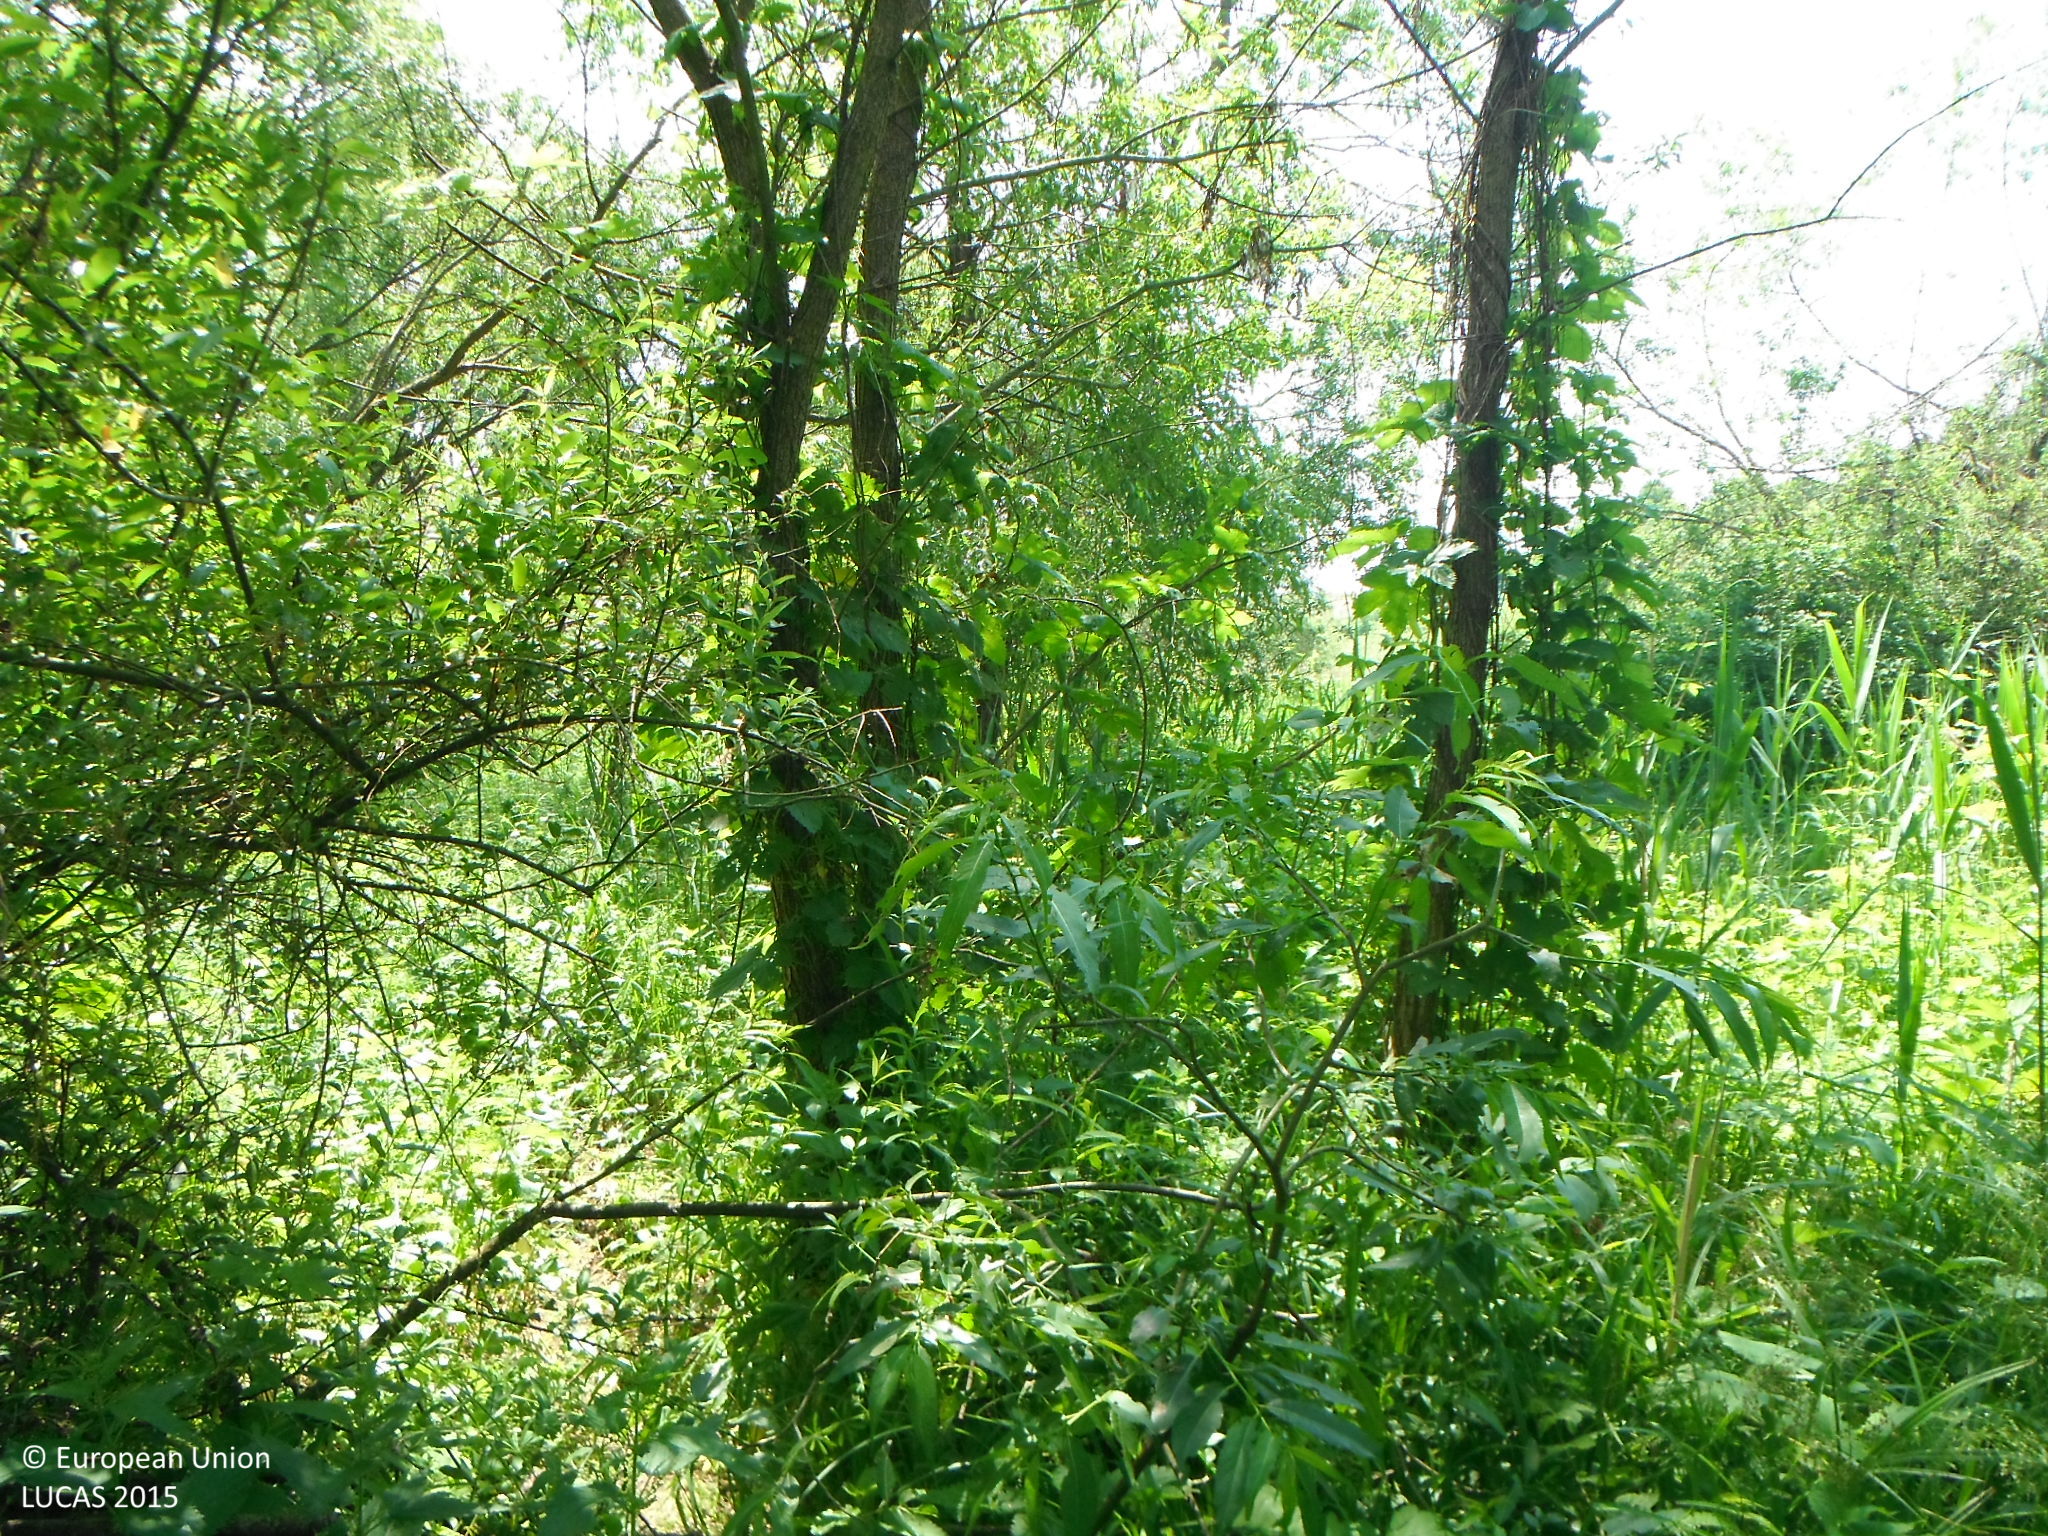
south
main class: Woodland
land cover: Broadleaved woodland
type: mire and swamp forests
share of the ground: > 75 %
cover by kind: broadleaved forest trees 85 %, shrubs 10 %, herbaceous plants 5 %
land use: Semi-natural and natural areas not in use
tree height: > 5 m
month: June
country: SK
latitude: 48.6876
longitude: 19.2191
